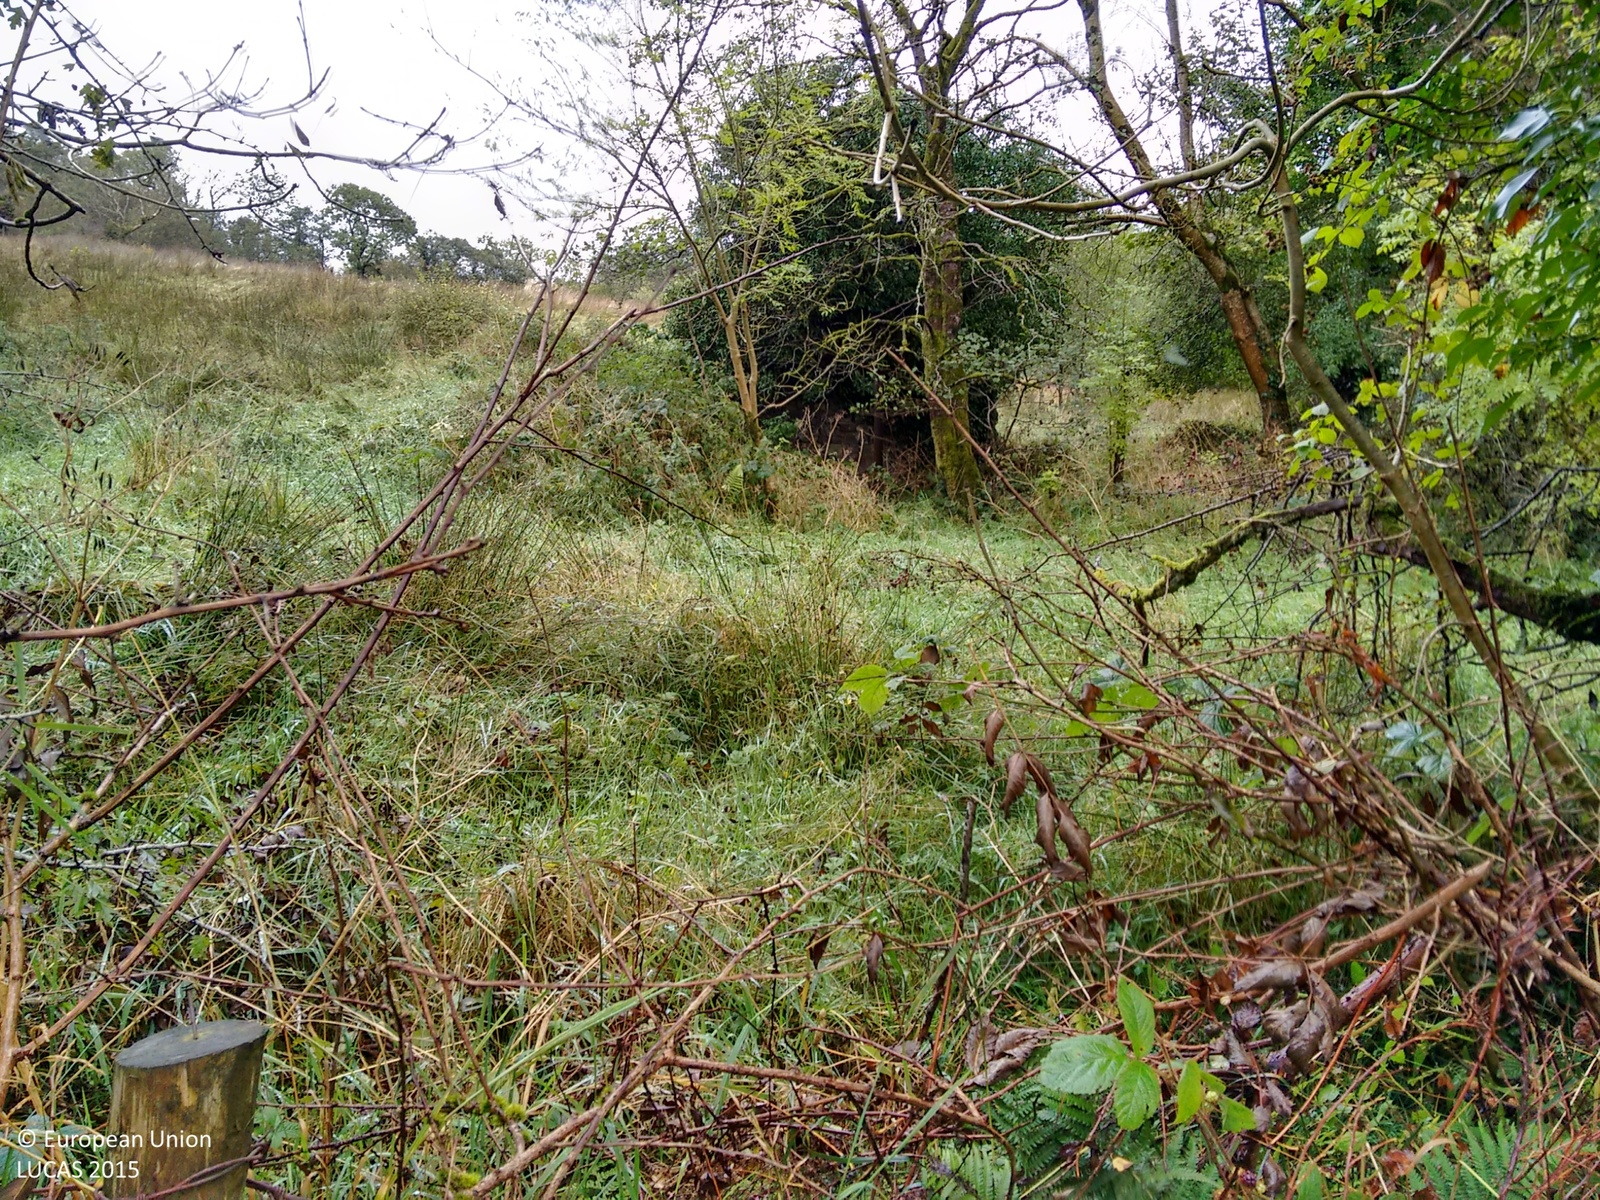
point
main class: Grassland
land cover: Grassland with sparse tree/shrub cover
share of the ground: > 75 %
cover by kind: herbaceous plants 95 %, broadleaved forest trees 5 %
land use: Agriculture (excluding fallow land and kitchen gardens)
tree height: < 5 m
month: October
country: GB
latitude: 54.5134
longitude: -7.4702
